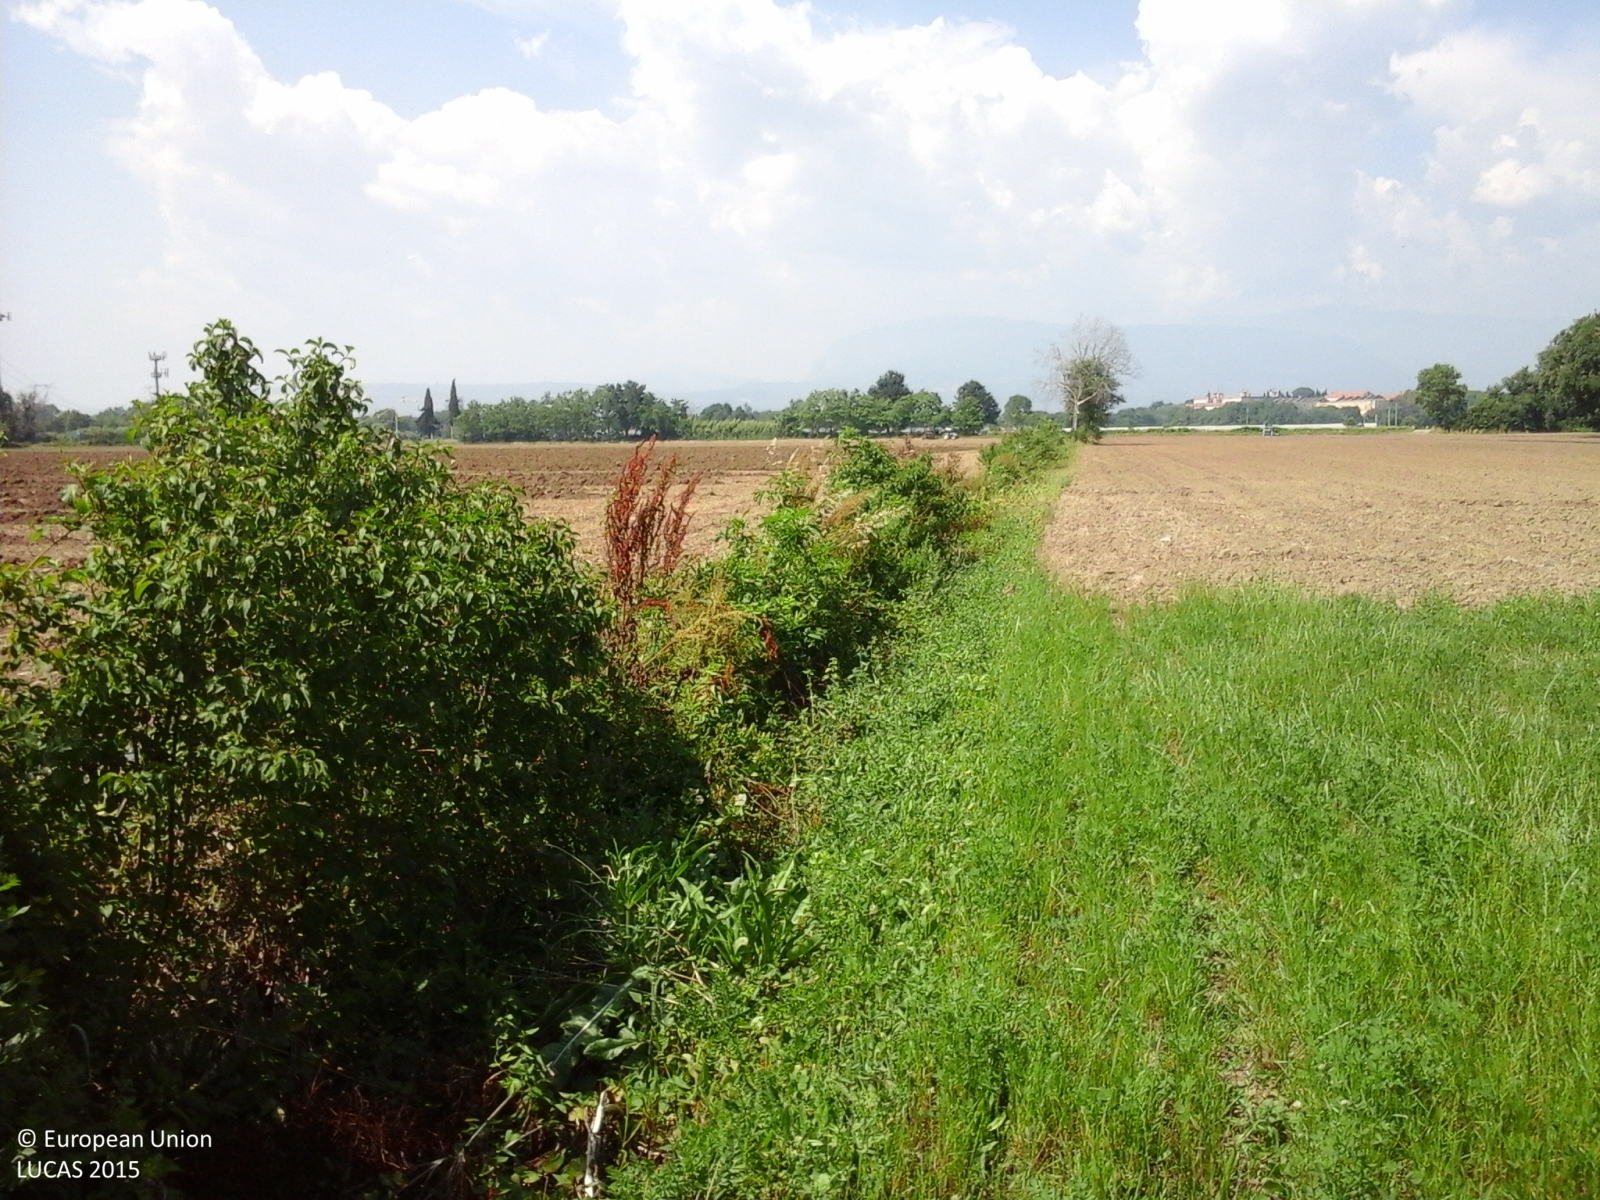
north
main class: Cropland
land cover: Lucerne
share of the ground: > 75 %
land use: Agriculture (excluding fallow land and kitchen gardens)
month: June
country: IT
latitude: 40.5364
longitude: 15.0436
